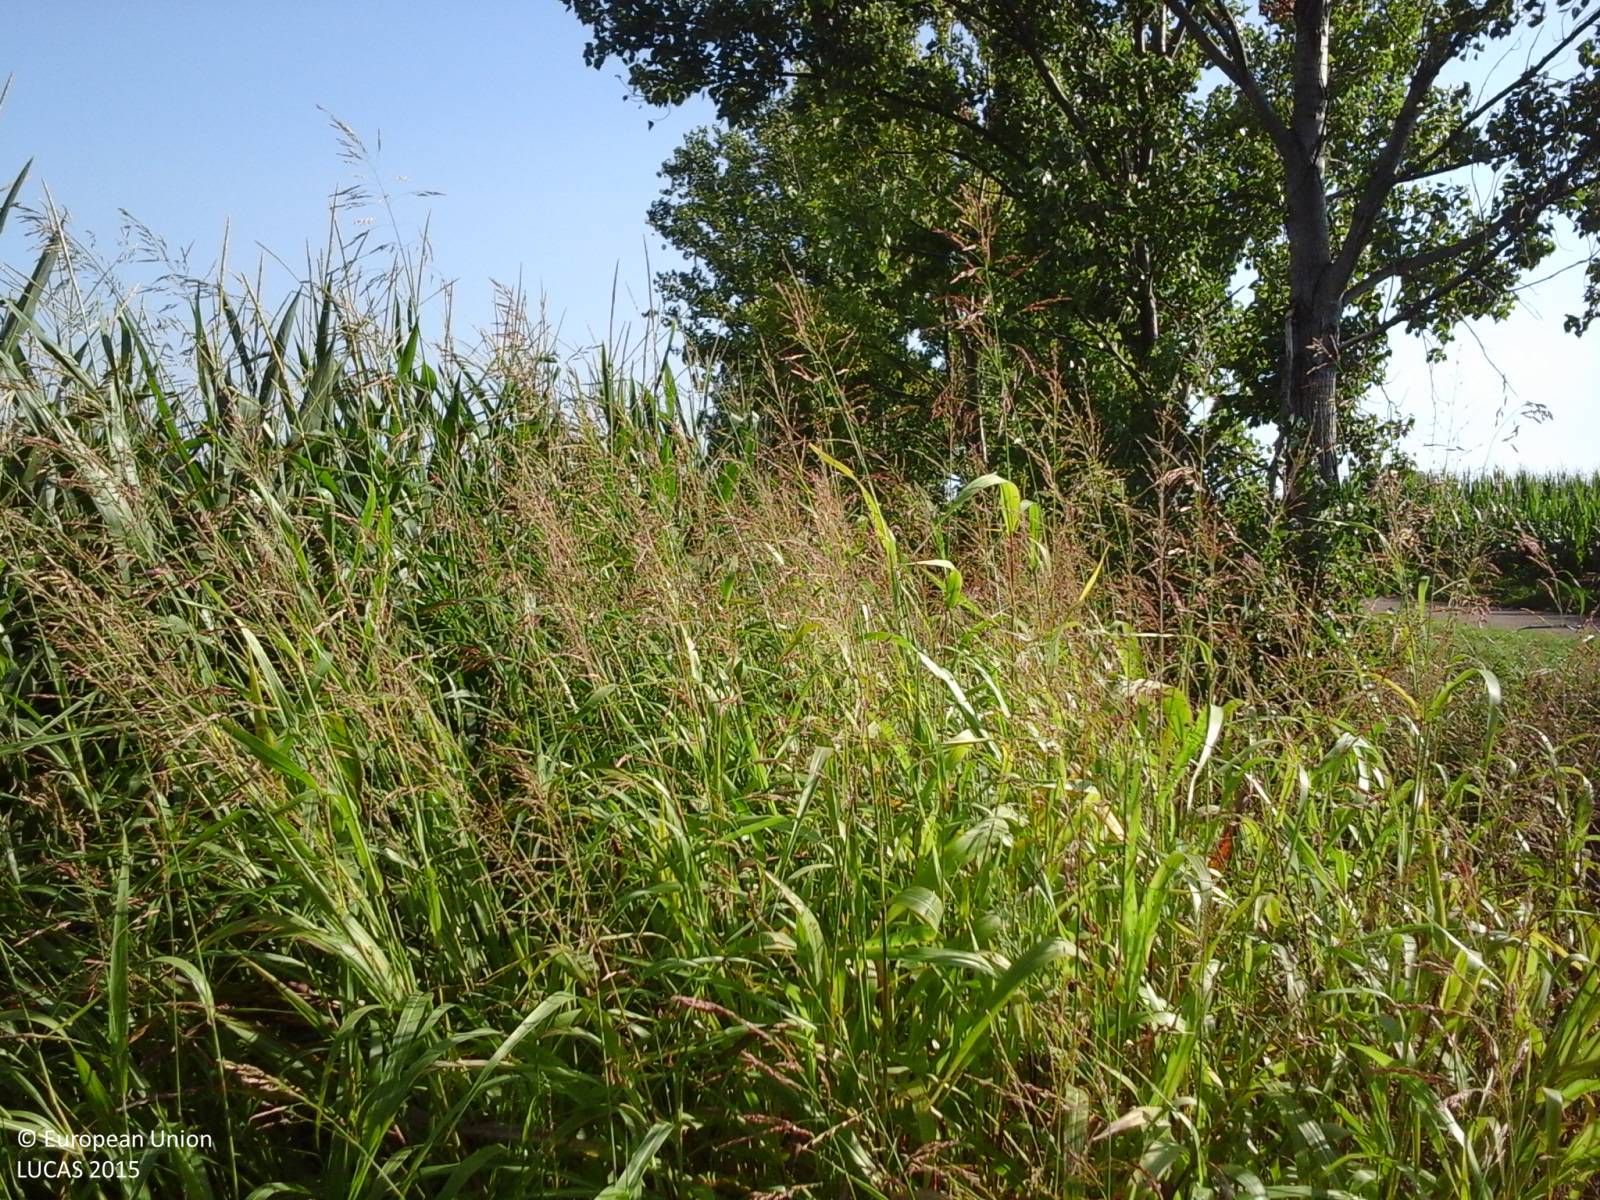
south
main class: Cropland
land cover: Maize
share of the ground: > 75 %
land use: Agriculture (excluding fallow land and kitchen gardens)
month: August
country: IT
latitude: 41.4113
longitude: 13.1576
